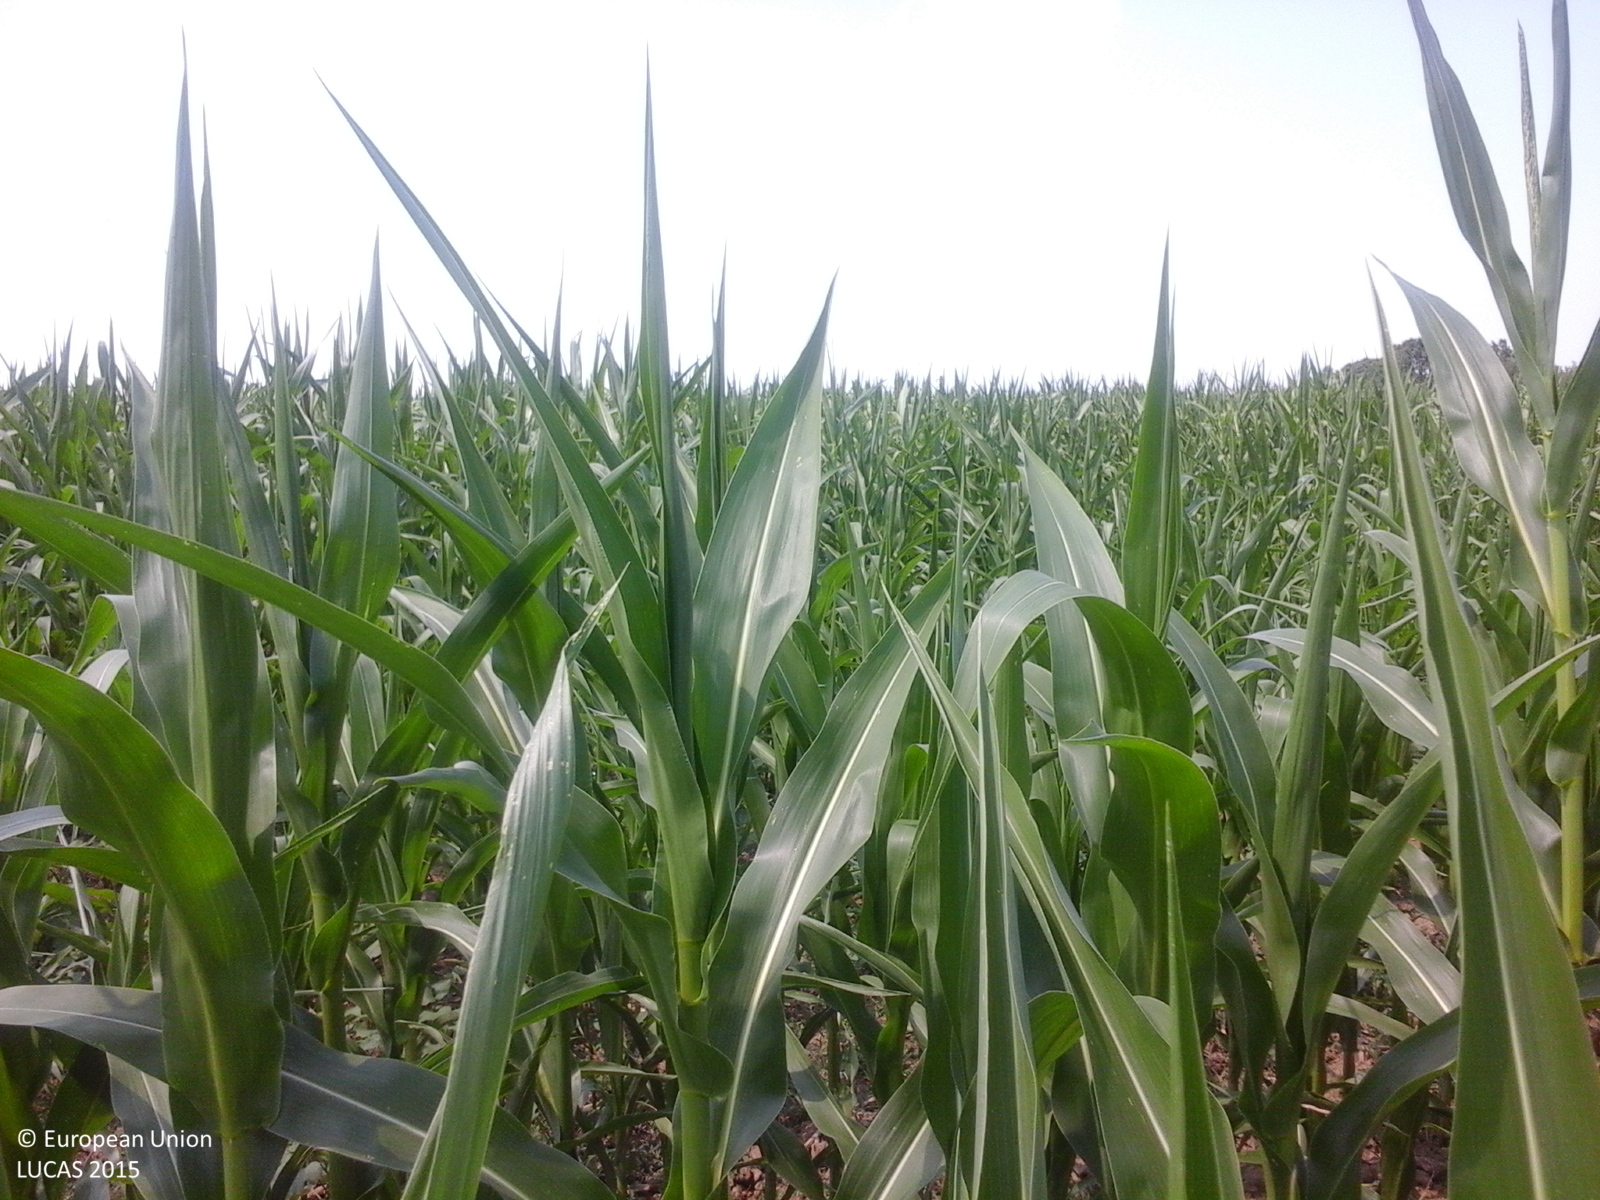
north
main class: Cropland
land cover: Maize
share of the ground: > 75 %
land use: Agriculture (excluding fallow land and kitchen gardens)
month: July
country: RO
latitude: 44.7199
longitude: 24.7347
